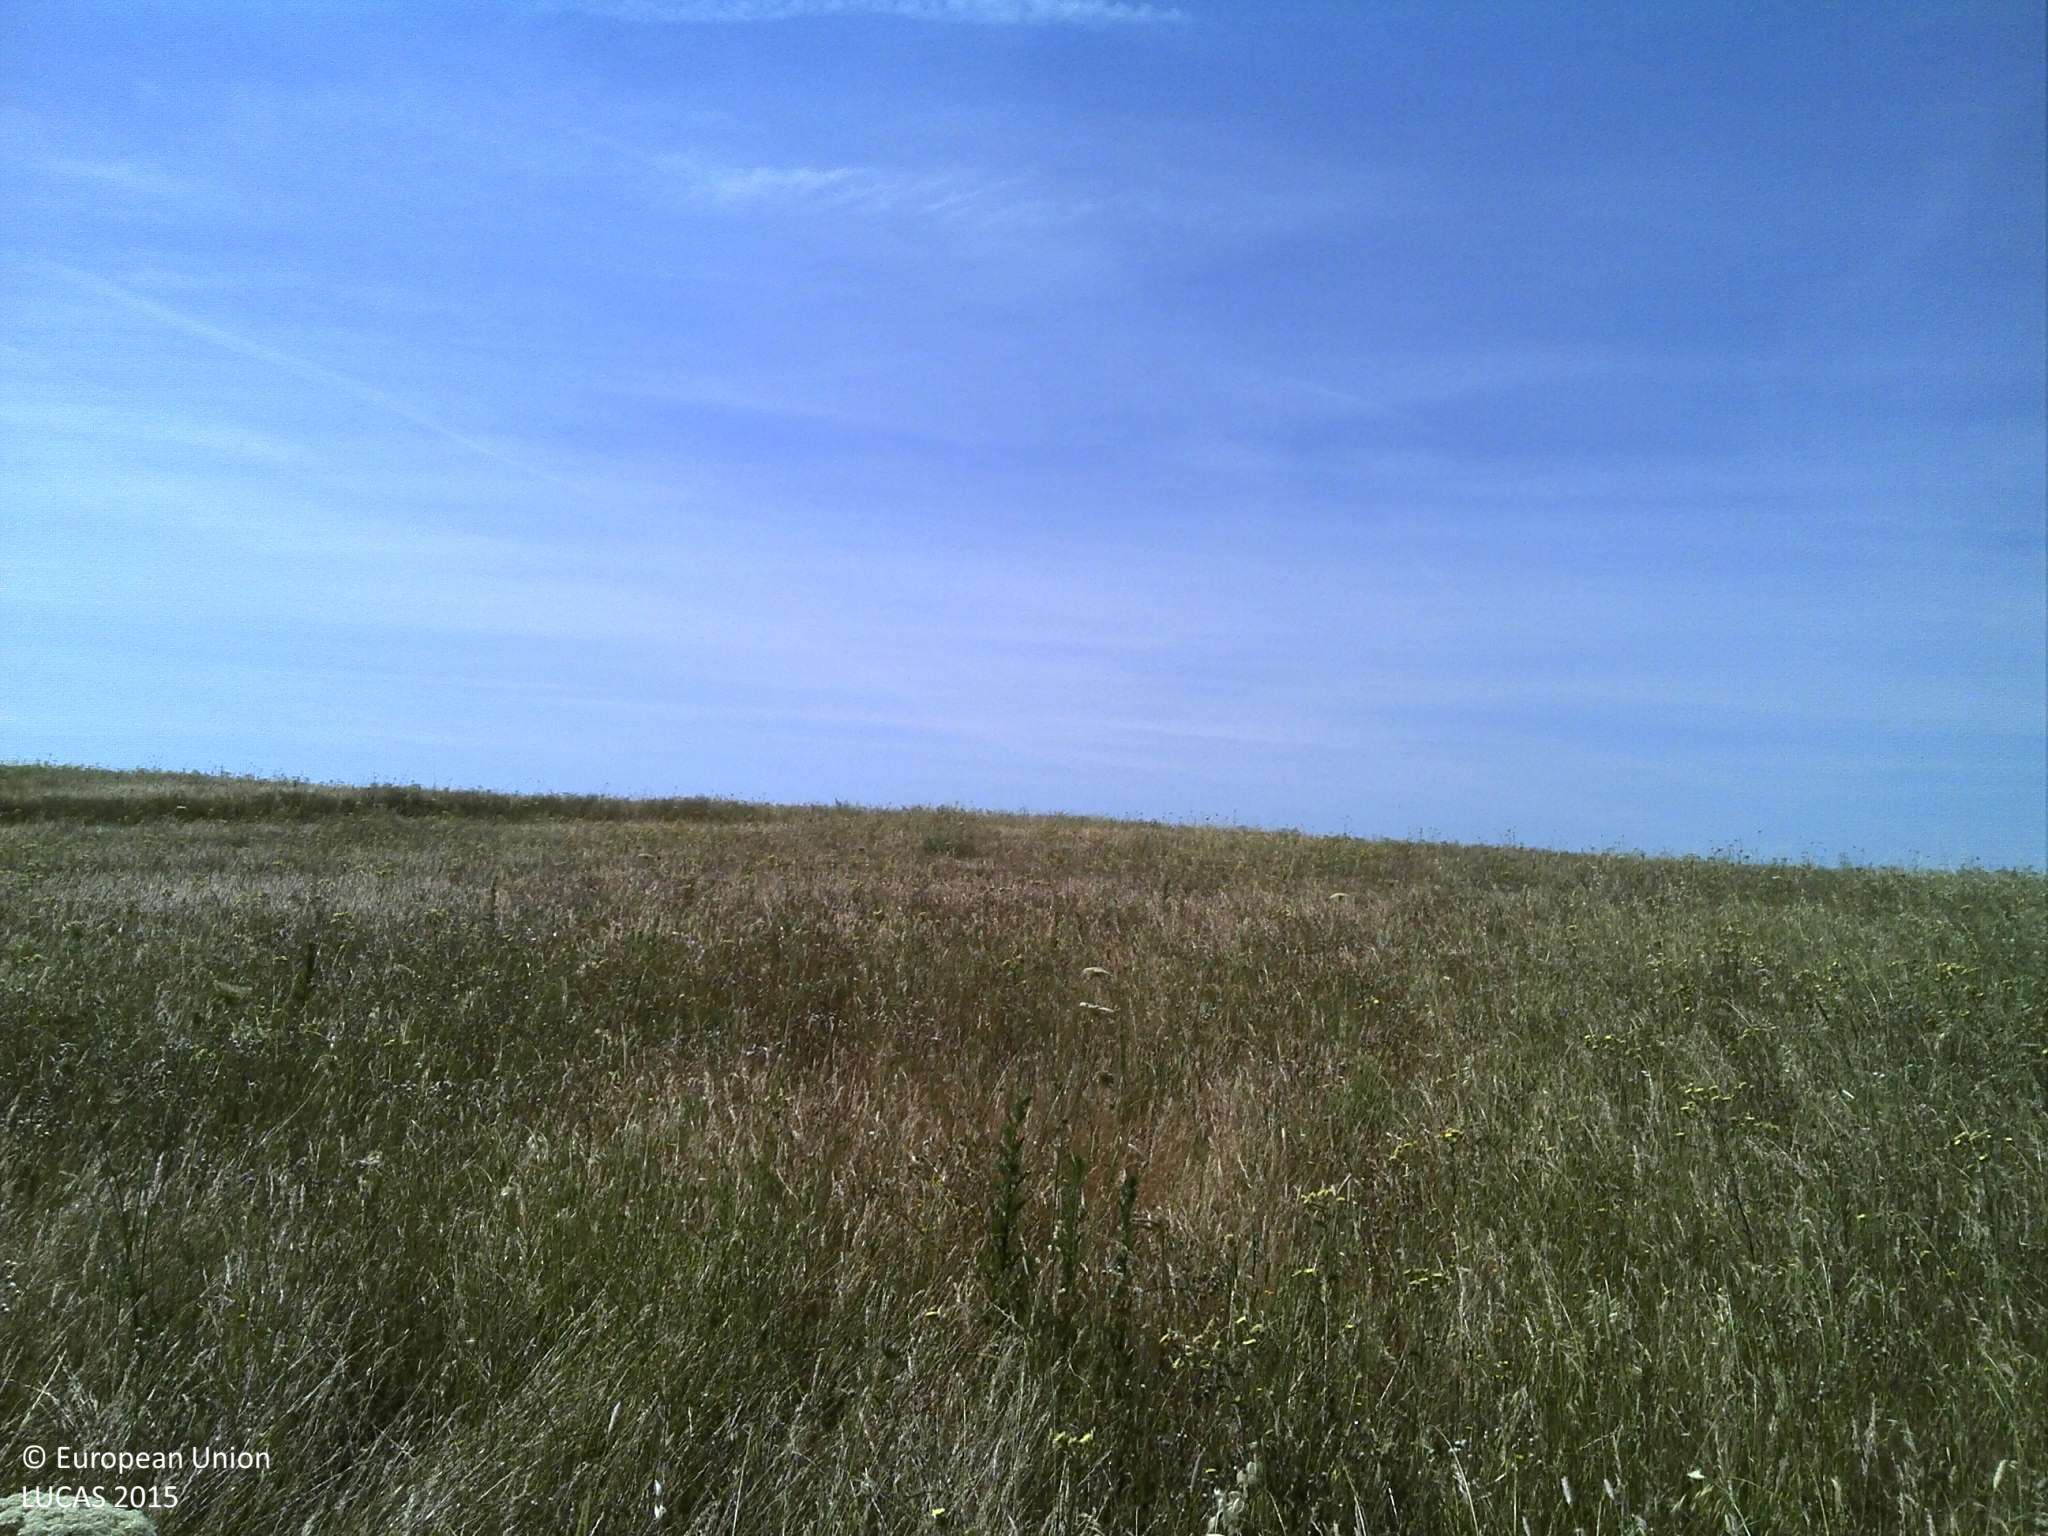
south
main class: Grassland
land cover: Grassland without tree/shrub cover
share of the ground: > 75 %
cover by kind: herbaceous plants 90 %, unconsolidated bare surface 10 %
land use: Agriculture (excluding fallow land and kitchen gardens)
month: May
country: PT
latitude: 39.0822
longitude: -7.6251
